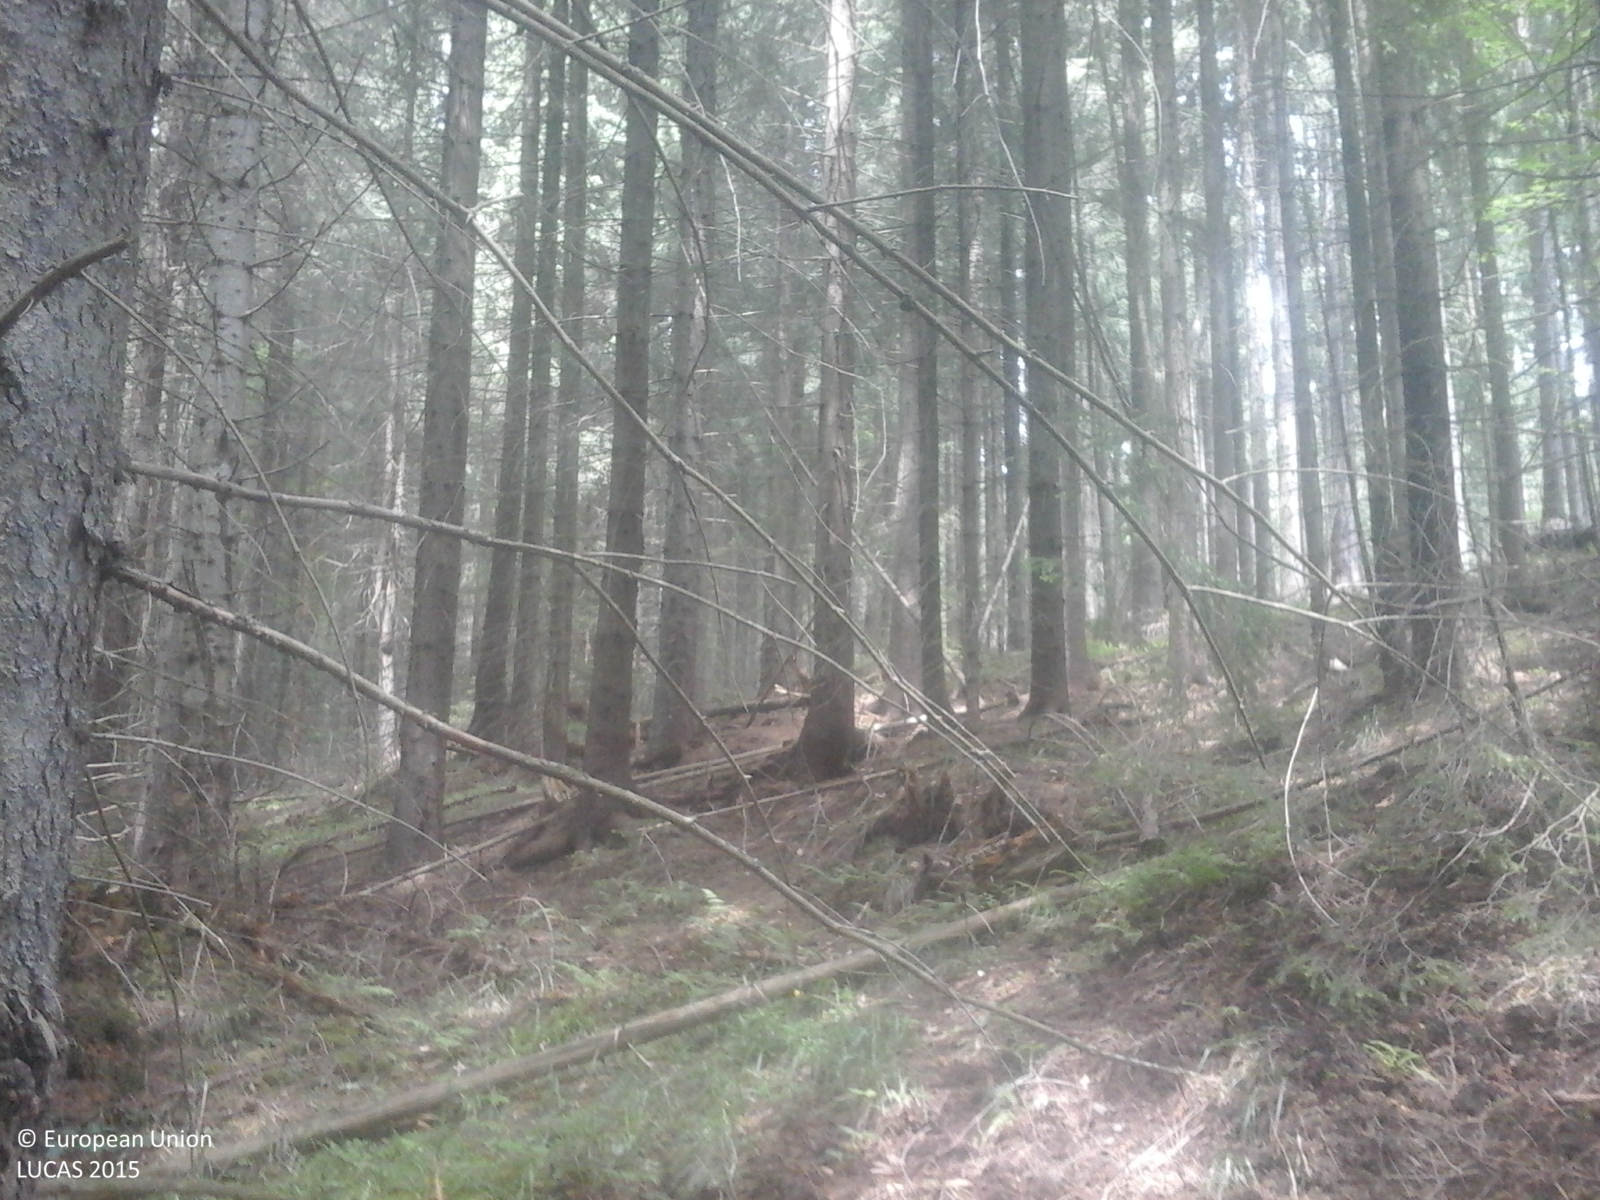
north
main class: Woodland
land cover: Spruce dominated coniferous woodland
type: alpine coniferous forest
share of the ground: > 75 %
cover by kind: coniferous forest trees 90 %, broadleaved forest trees 10 %
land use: Forestry
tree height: > 5 m
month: June
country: RO
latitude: 47.4281
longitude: 25.1272
